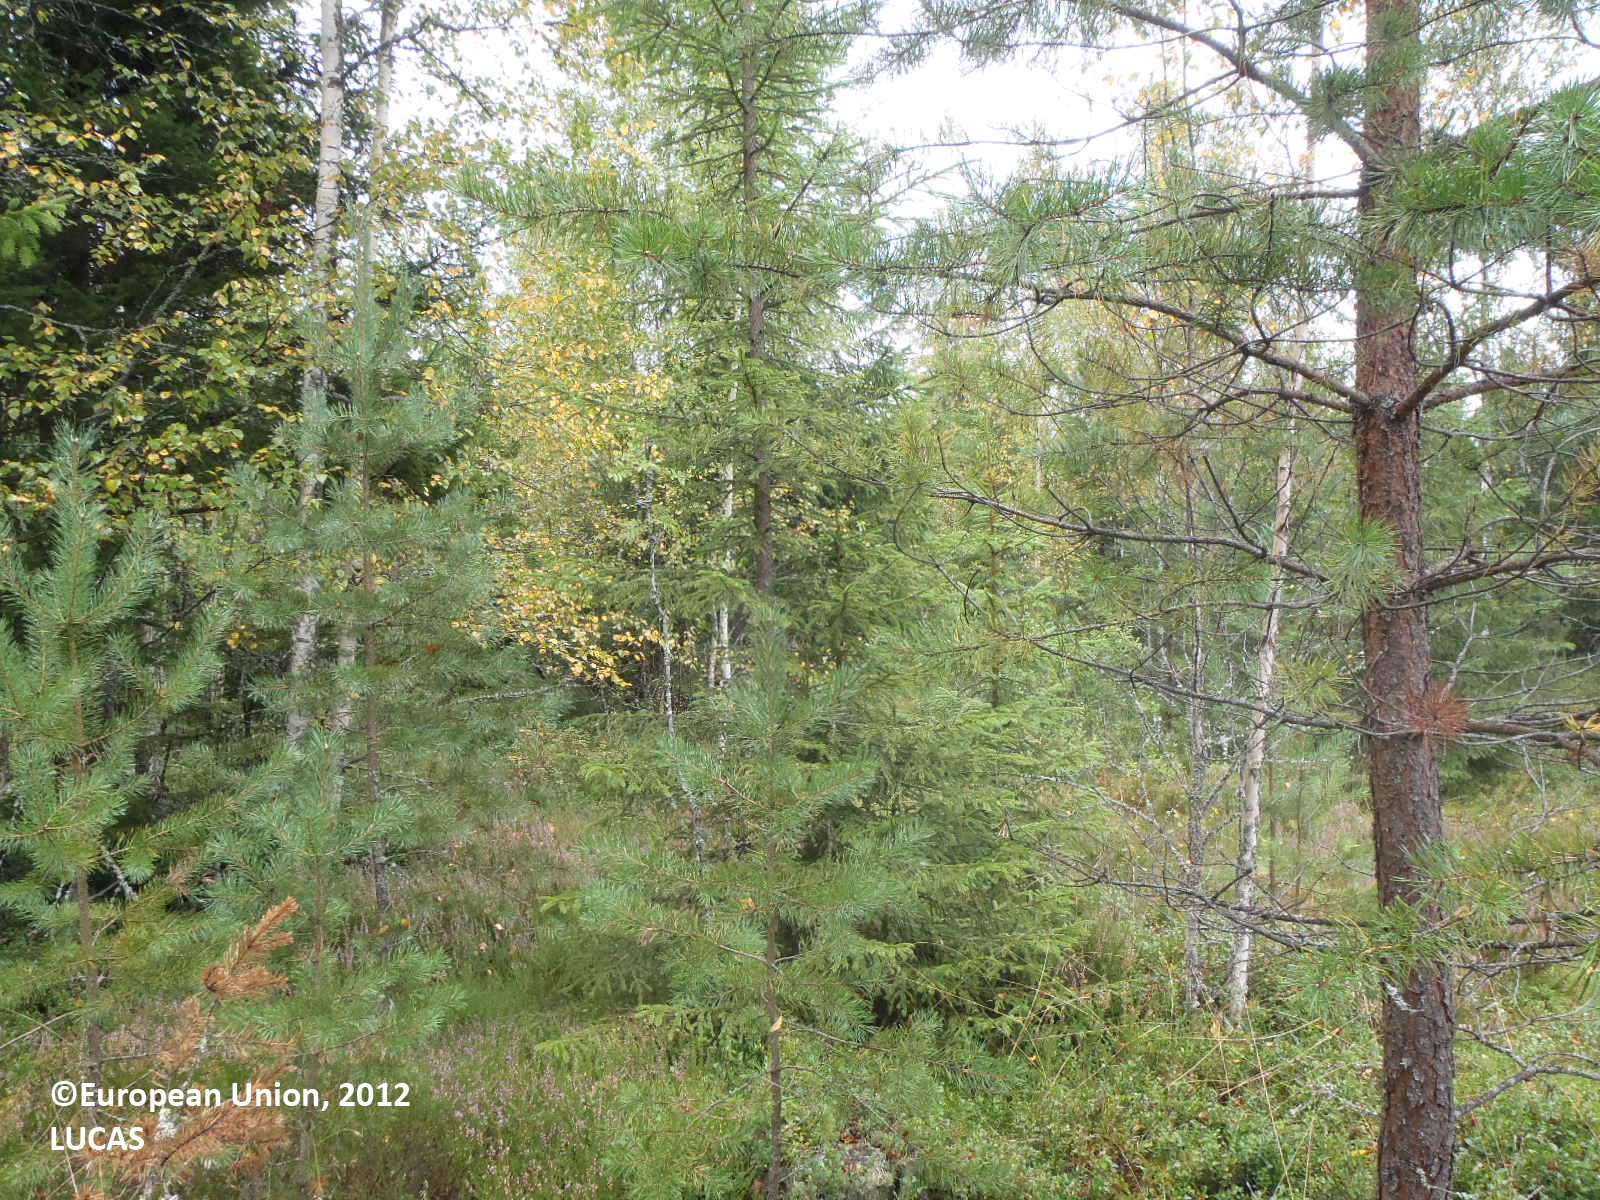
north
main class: Woodland
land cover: Other mixed woodland
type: boreal forest
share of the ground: 50 - 75 %
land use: Forestry
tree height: > 5 m
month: September
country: FI
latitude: 60.7327
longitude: 22.7433
